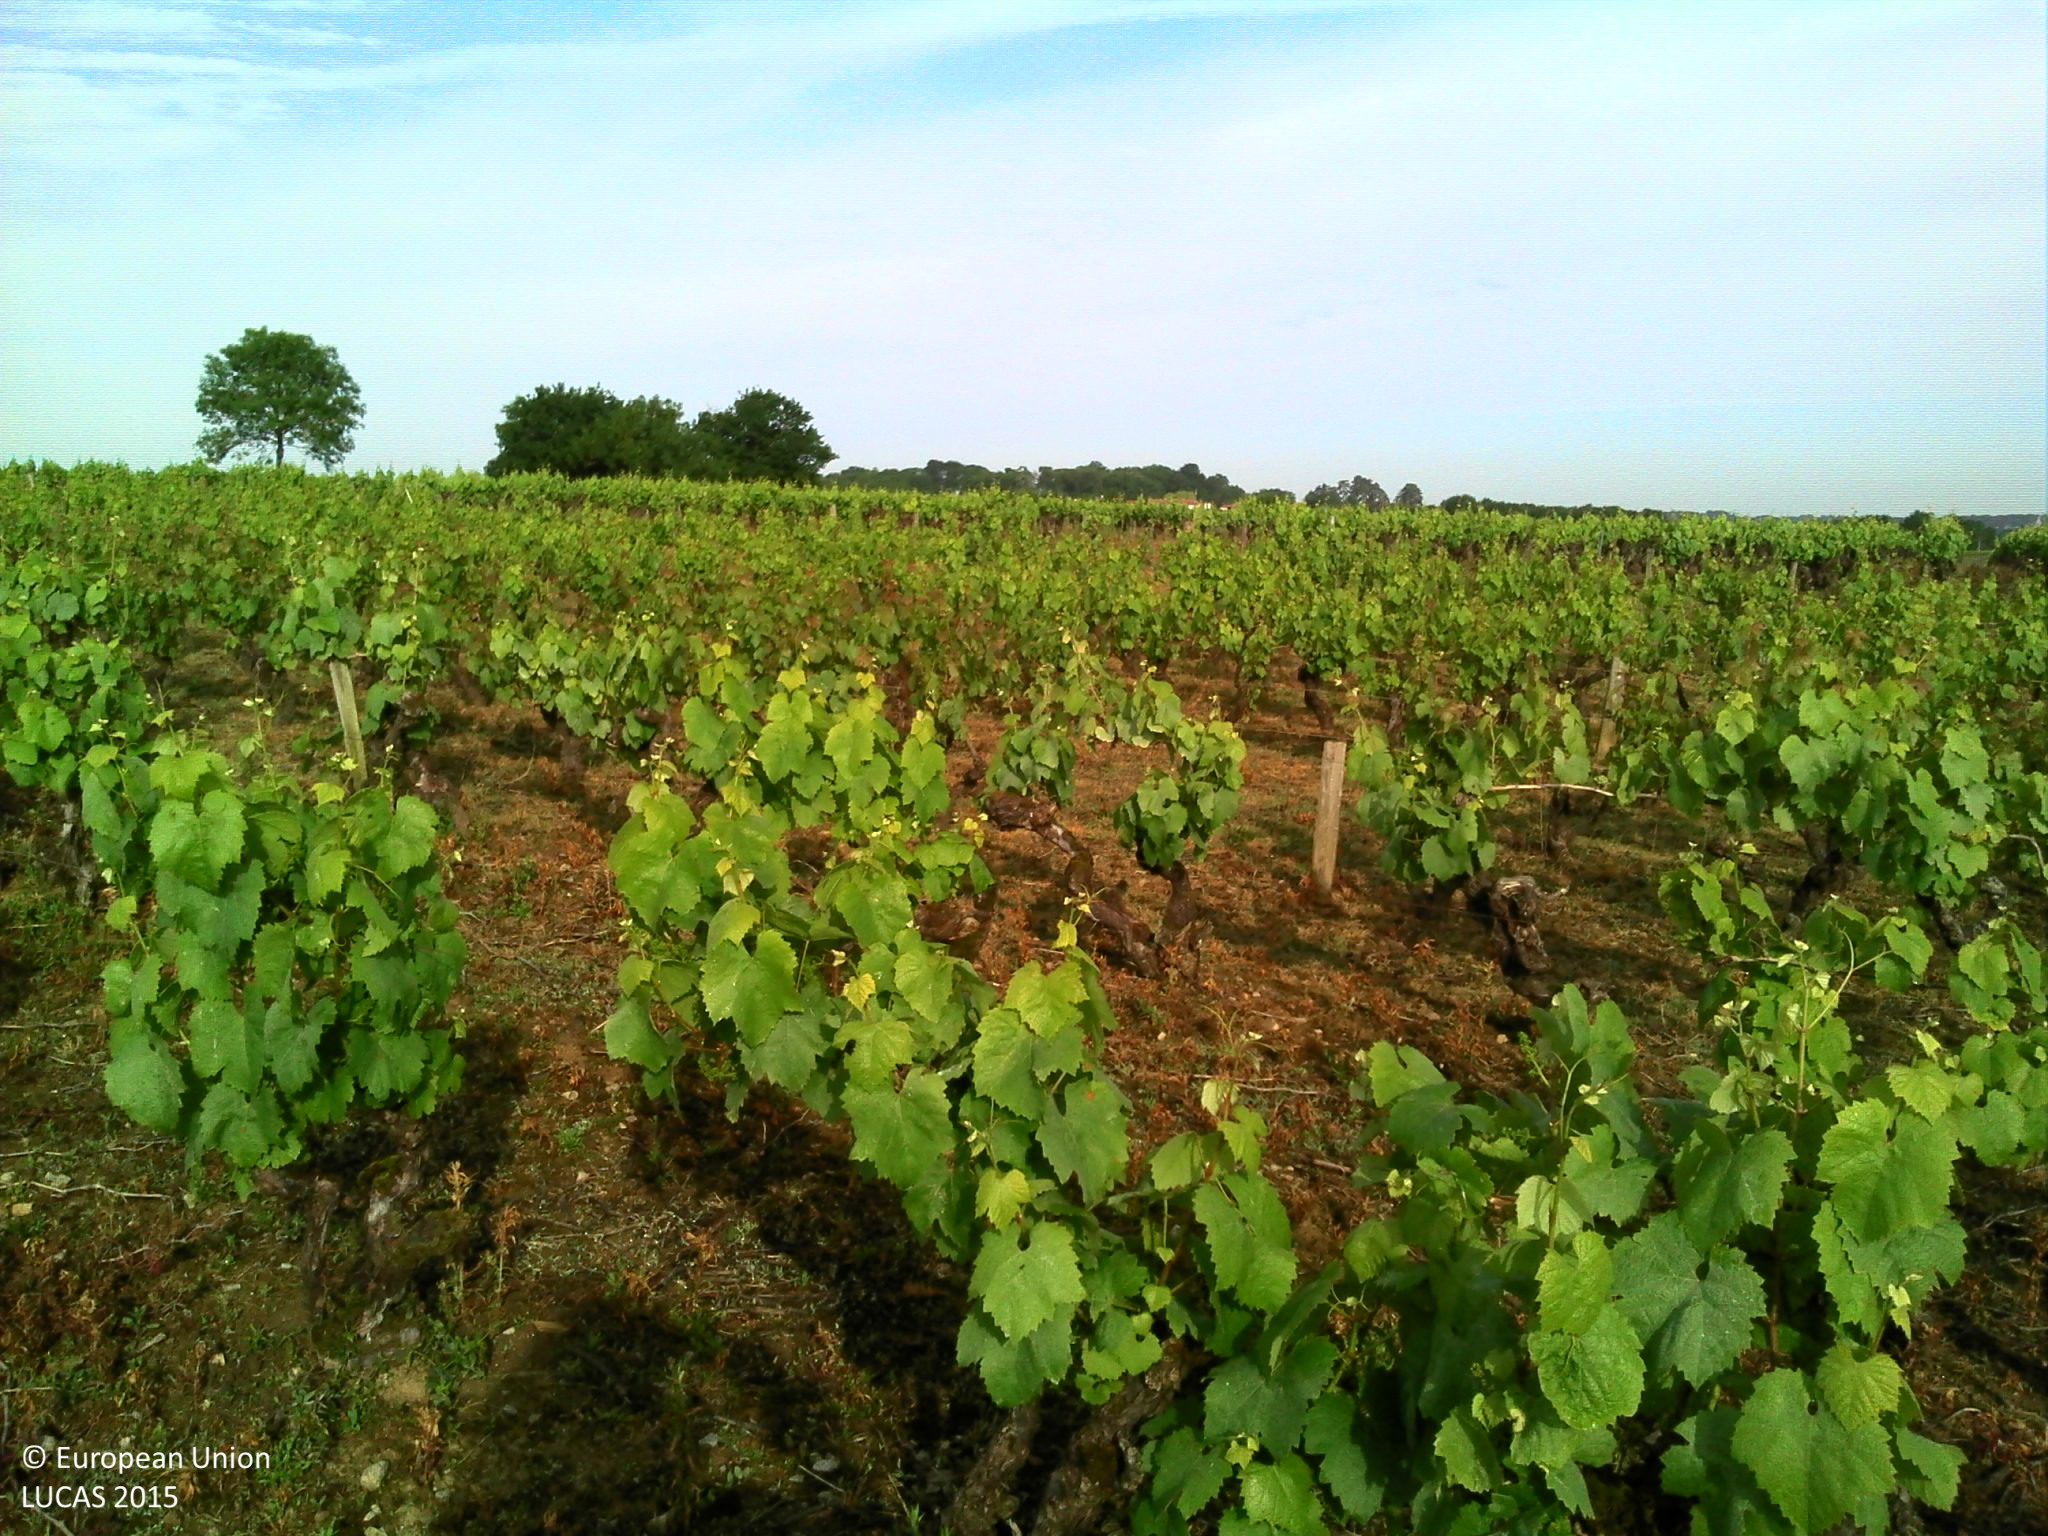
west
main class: Cropland
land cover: Vineyards
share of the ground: > 75 %
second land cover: Spontaneously vegetated surfaces
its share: 25 - 50 %
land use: Agriculture (excluding fallow land and kitchen gardens)
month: June
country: FR
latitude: 47.2960
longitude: -1.2930
